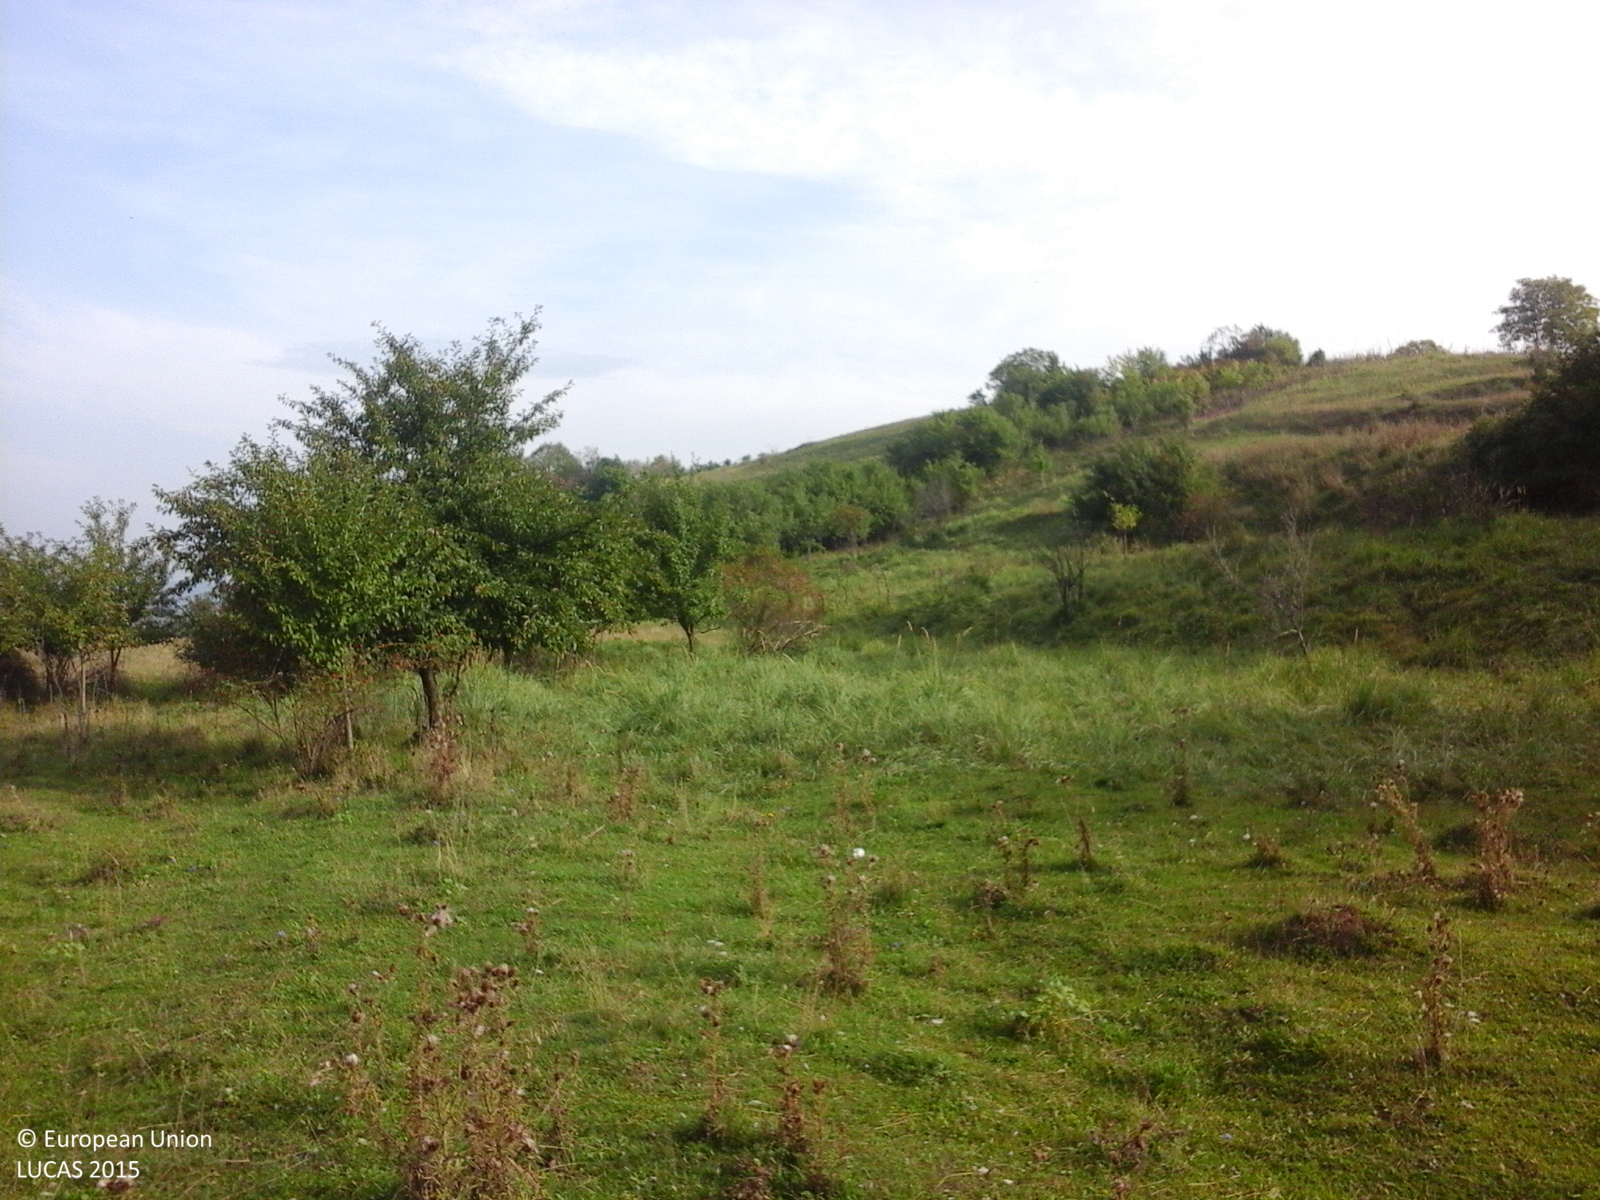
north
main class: Grassland
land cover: Grassland with sparse tree/shrub cover
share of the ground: > 75 %
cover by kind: herbaceous plants 85 %, shrubs 10 %, broadleaved forest trees 5 %
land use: Agriculture (excluding fallow land and kitchen gardens)
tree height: < 5 m
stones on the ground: < 10 %
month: September
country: RO
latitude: 46.8800
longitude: 23.0397
